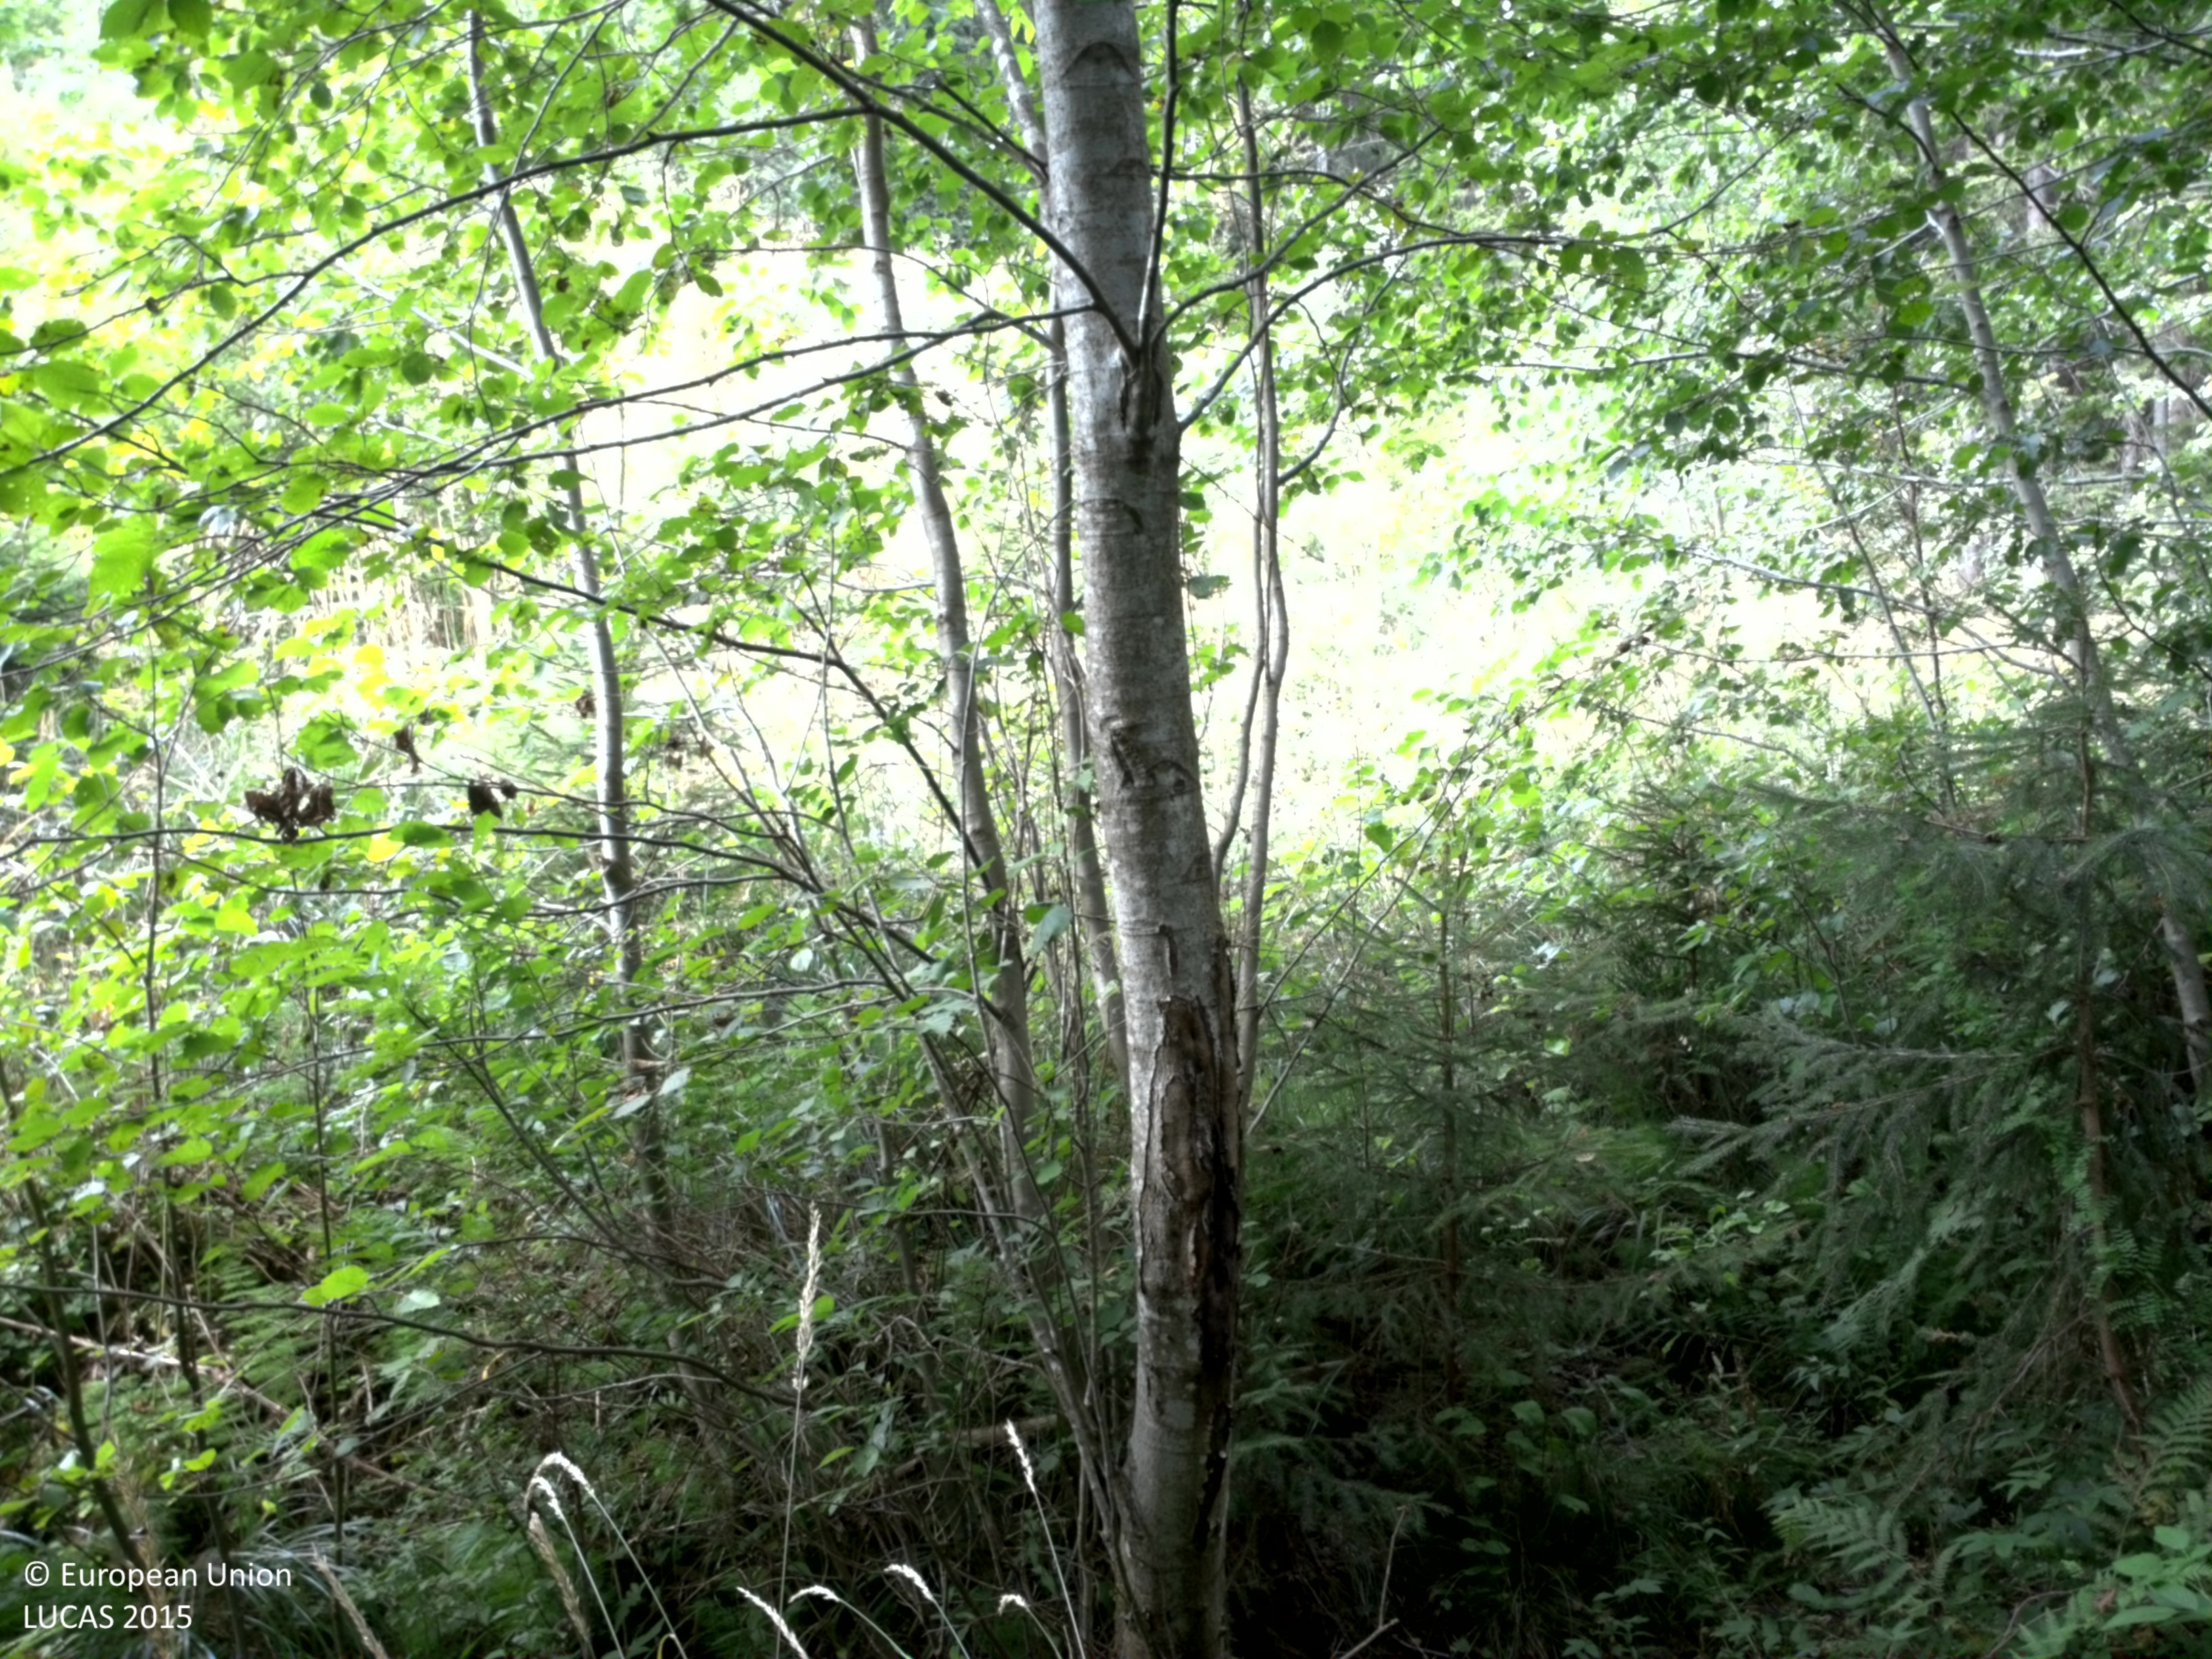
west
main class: Woodland
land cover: Spruce dominated mixed woodland
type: boreal forest
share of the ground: 50 - 75 %
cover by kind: coniferous forest trees 50 %, broadleaved forest trees 20 %, herbaceous plants 20 %, shrubs 10 %
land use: Forestry
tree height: > 5 m
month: August
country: SE
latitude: 59.5630
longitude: 13.4075
